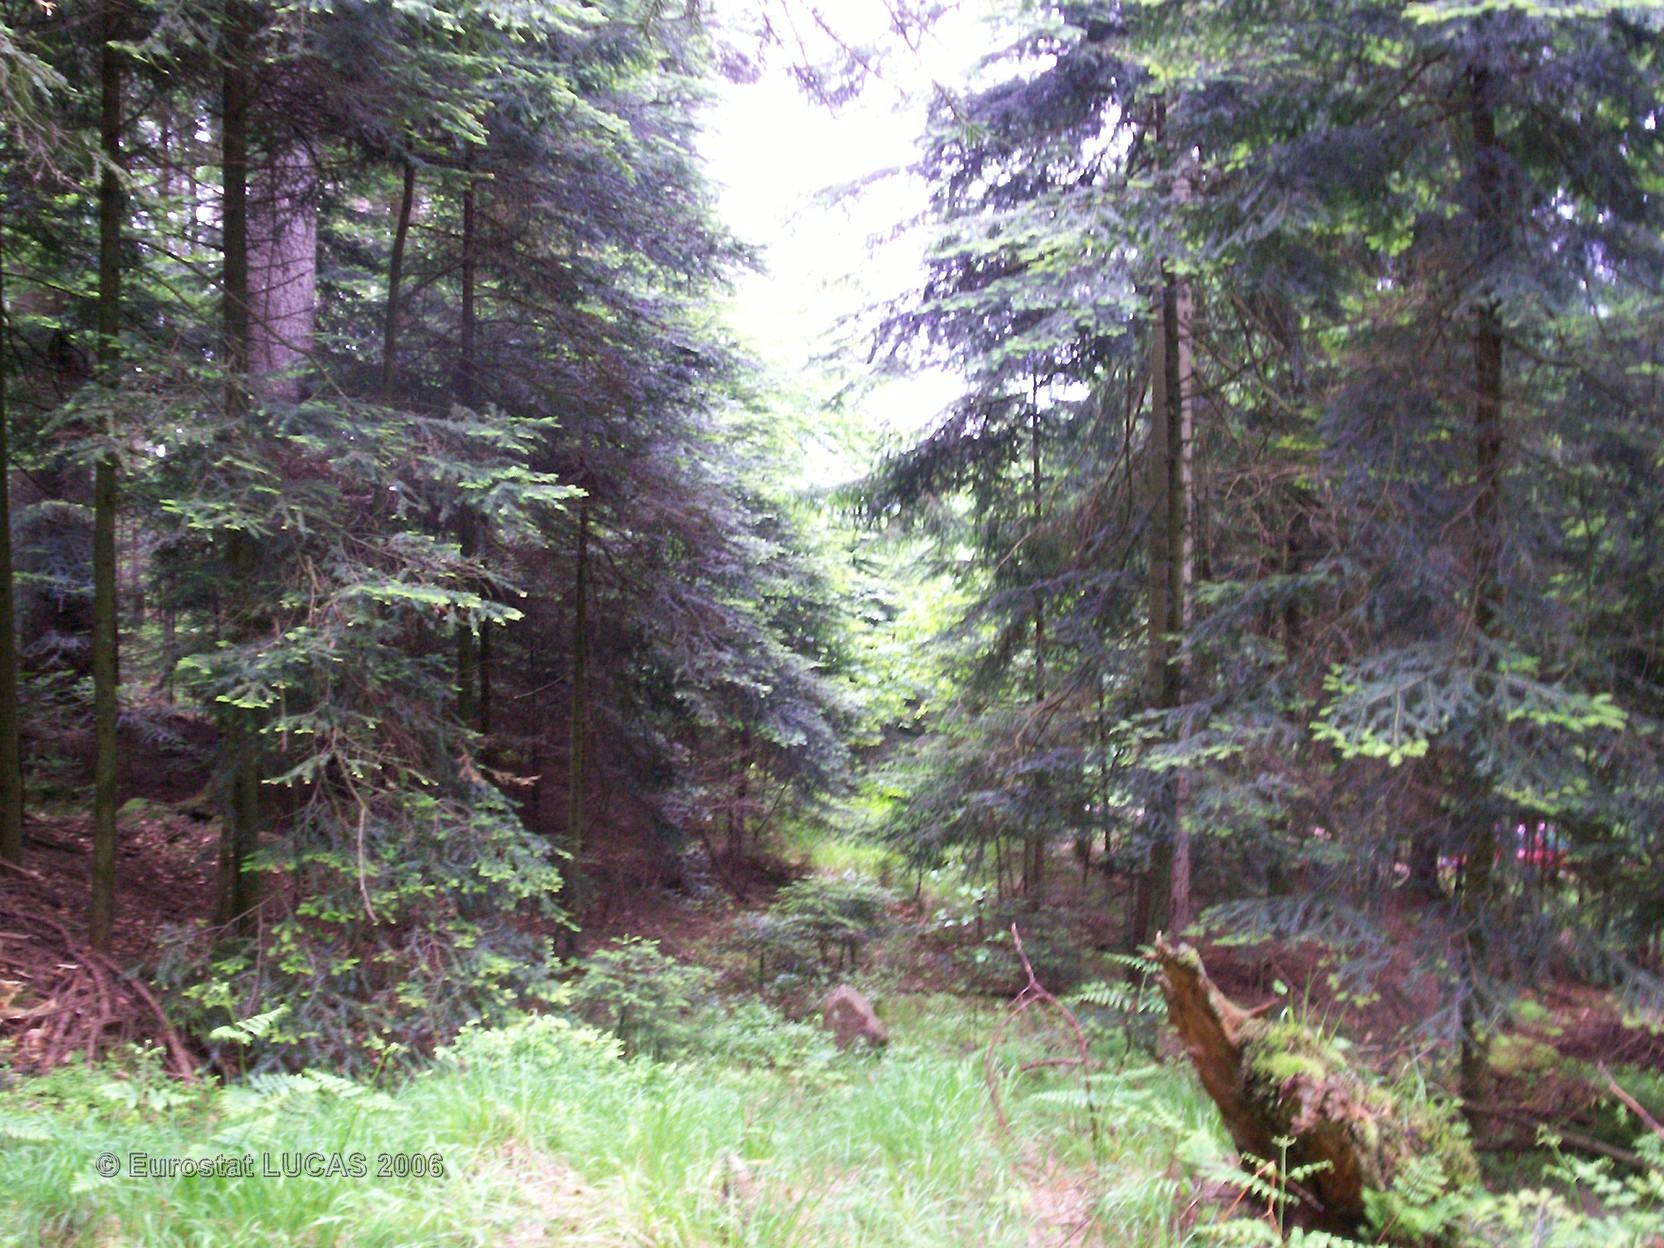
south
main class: Woodland
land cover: Mixed forest
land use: Forestry
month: June
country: FR
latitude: 48.3760
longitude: 6.8281
